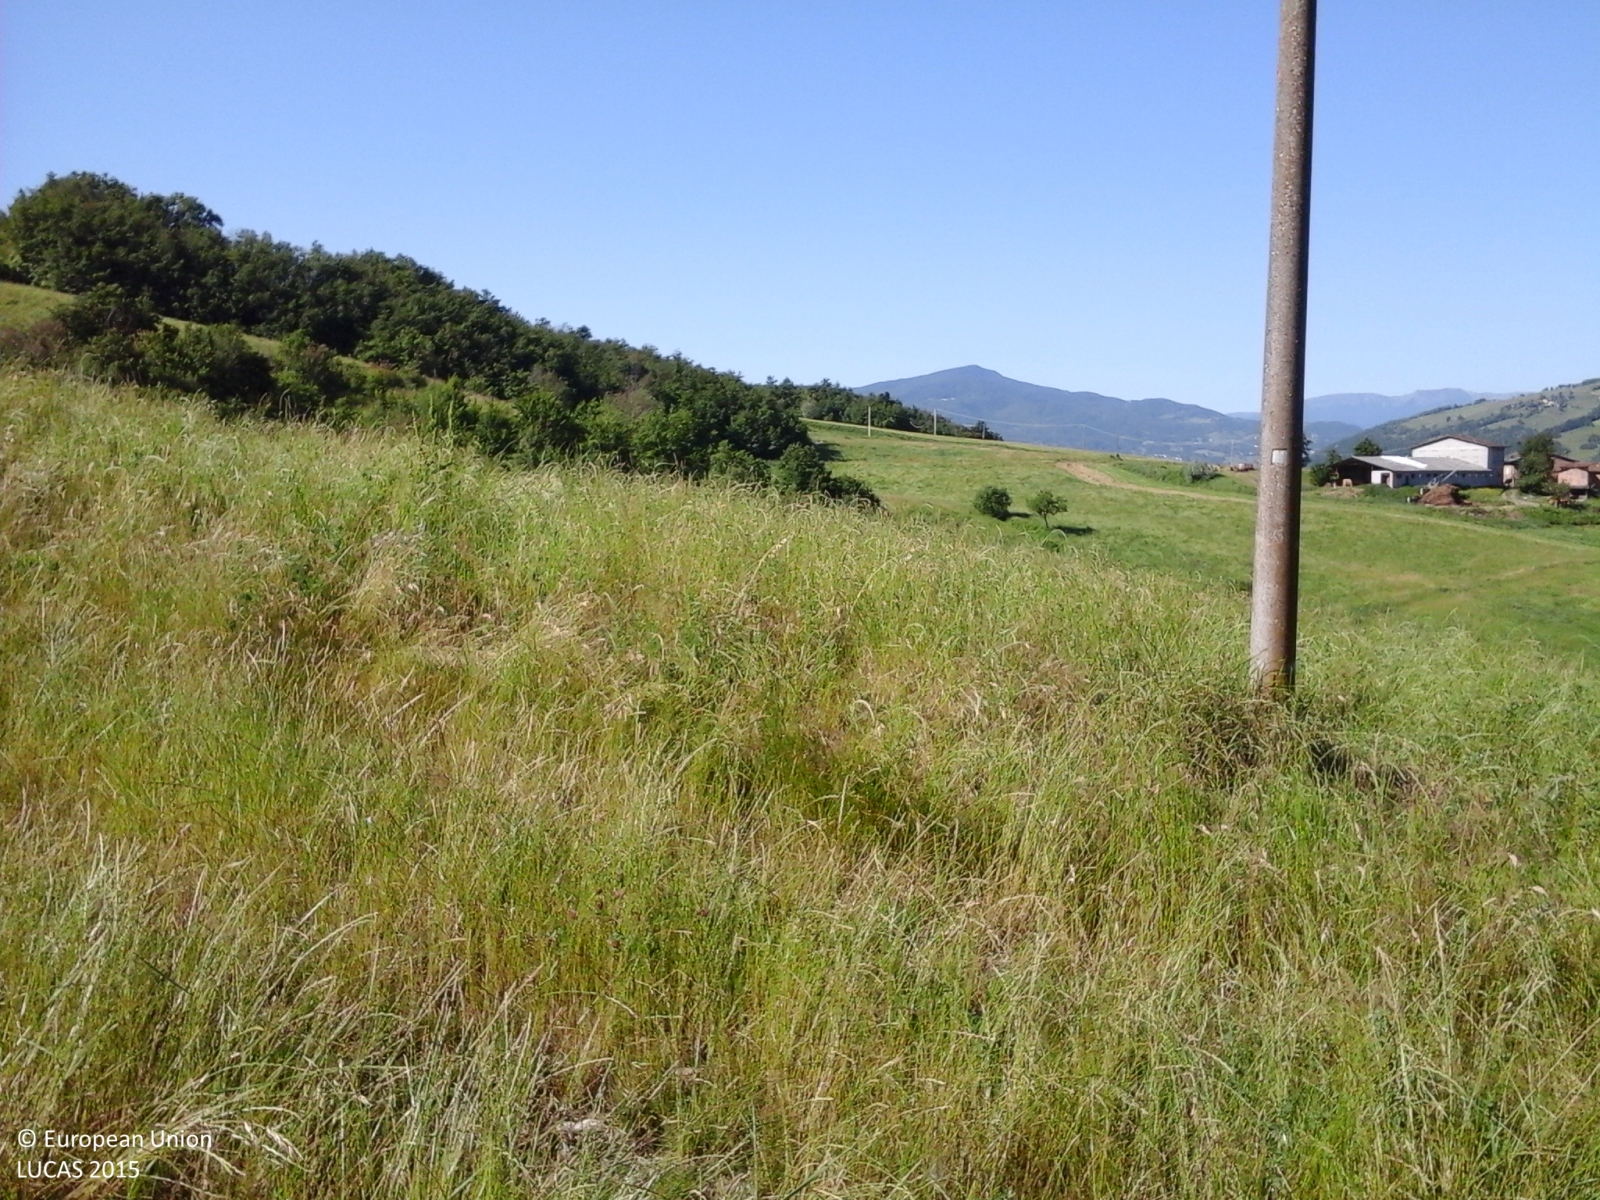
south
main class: Woodland
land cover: Broadleaved woodland
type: thermophilous deciduous forest
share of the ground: > 75 %
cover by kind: broadleaved forest trees 90 %, shrubs 5 %, herbaceous plants 5 %
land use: Forestry
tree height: > 5 m
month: May
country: IT
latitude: 44.4027
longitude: 10.6389
